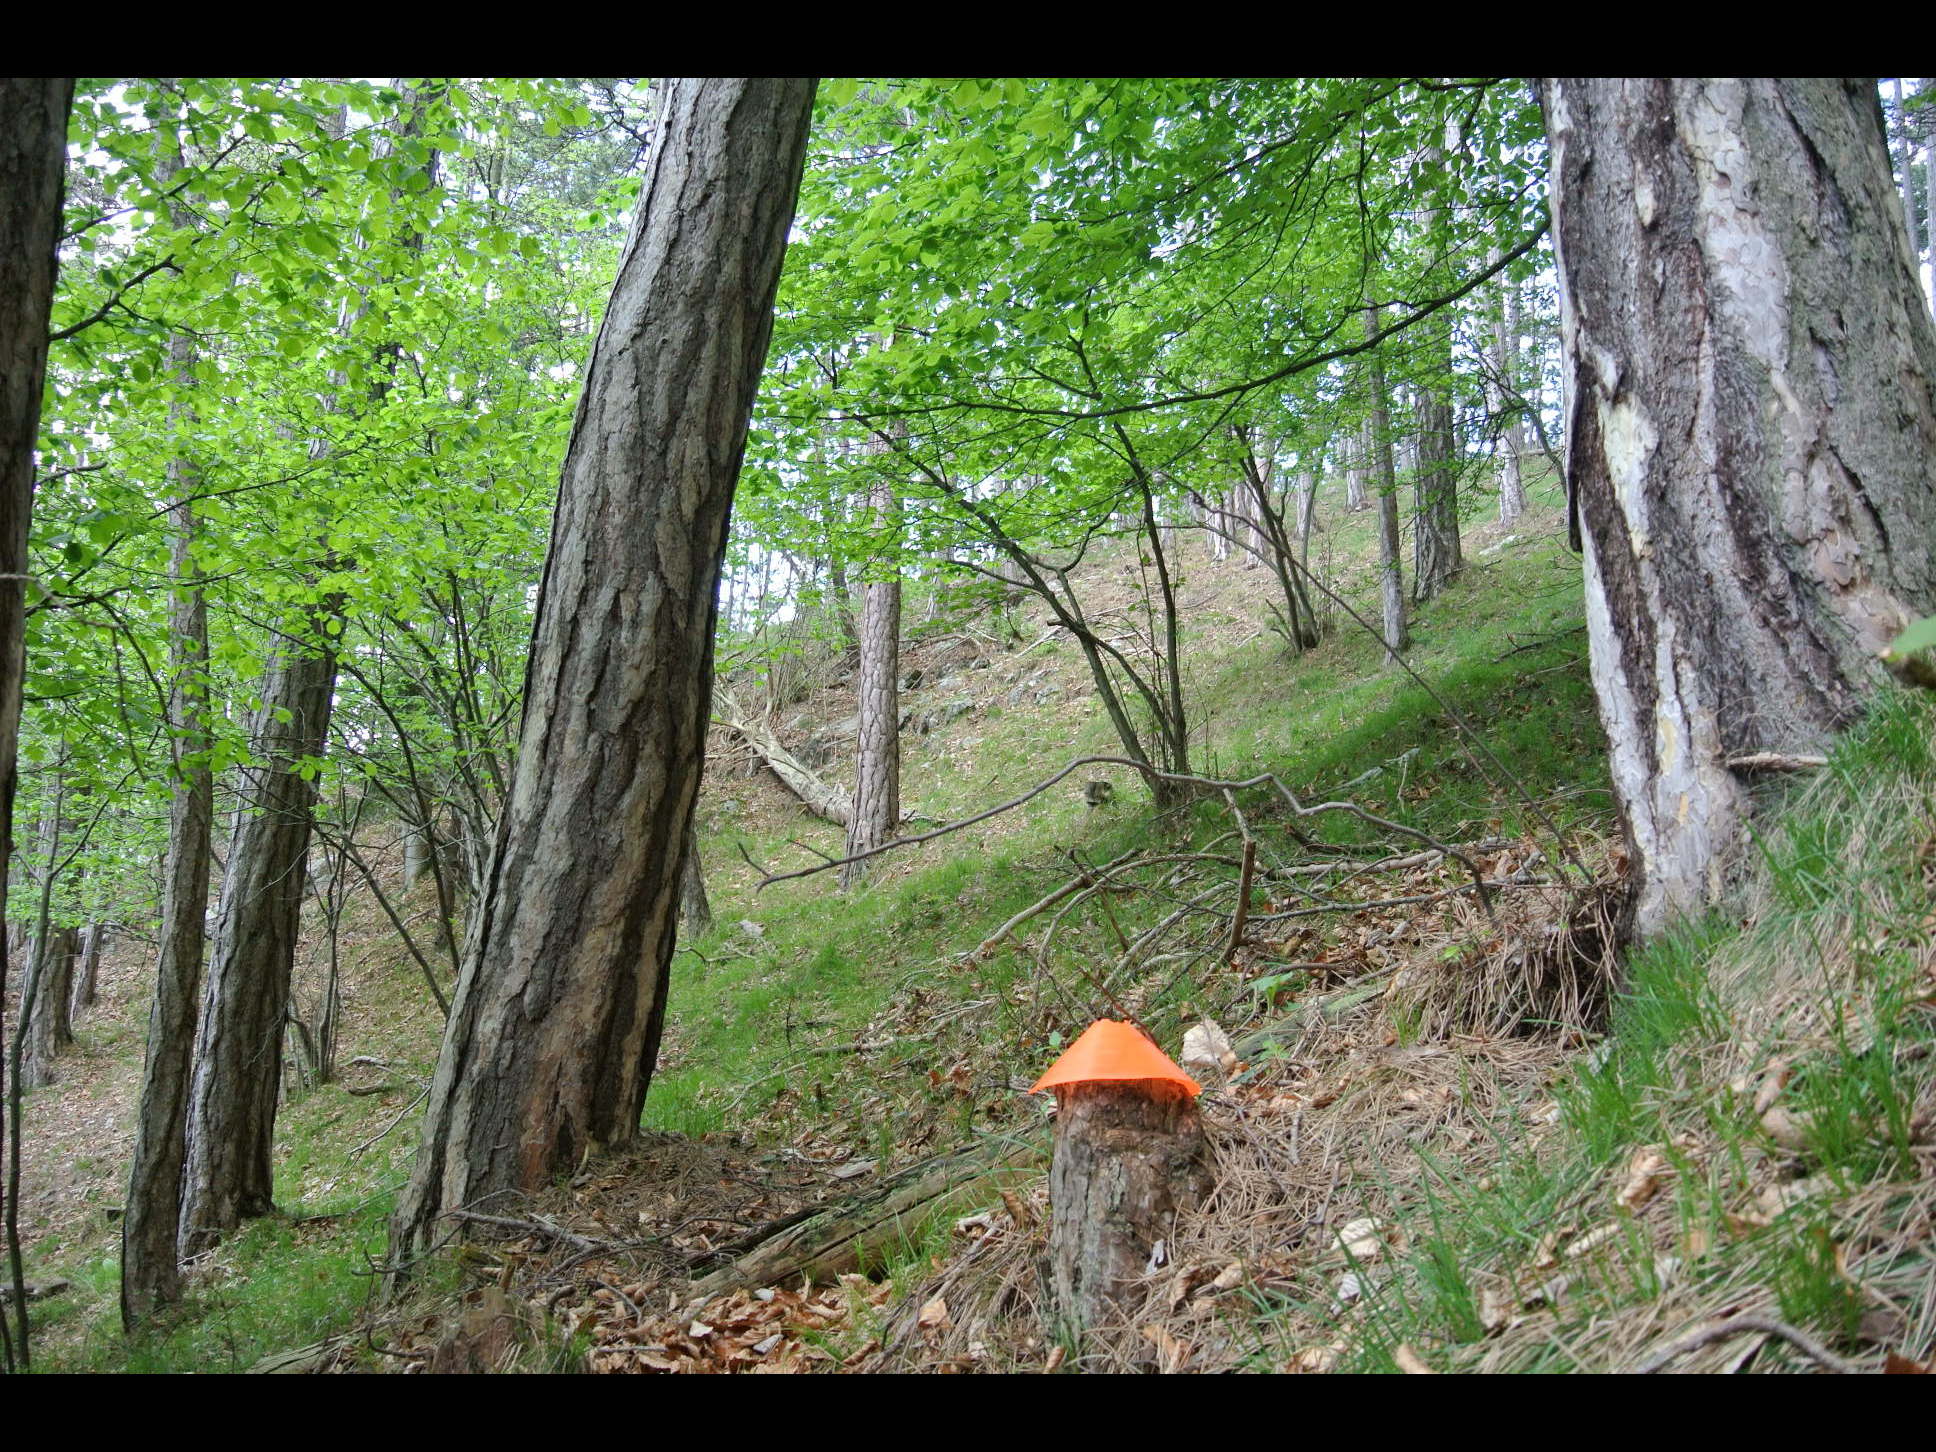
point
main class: Woodland
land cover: Pine dominated coniferous woodland
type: alpine coniferous forest
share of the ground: > 75 %
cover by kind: coniferous forest trees 95 %, broadleaved forest trees 5 %
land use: Forestry
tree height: > 5 m
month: May
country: AT
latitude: 47.8778
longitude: 16.0336
